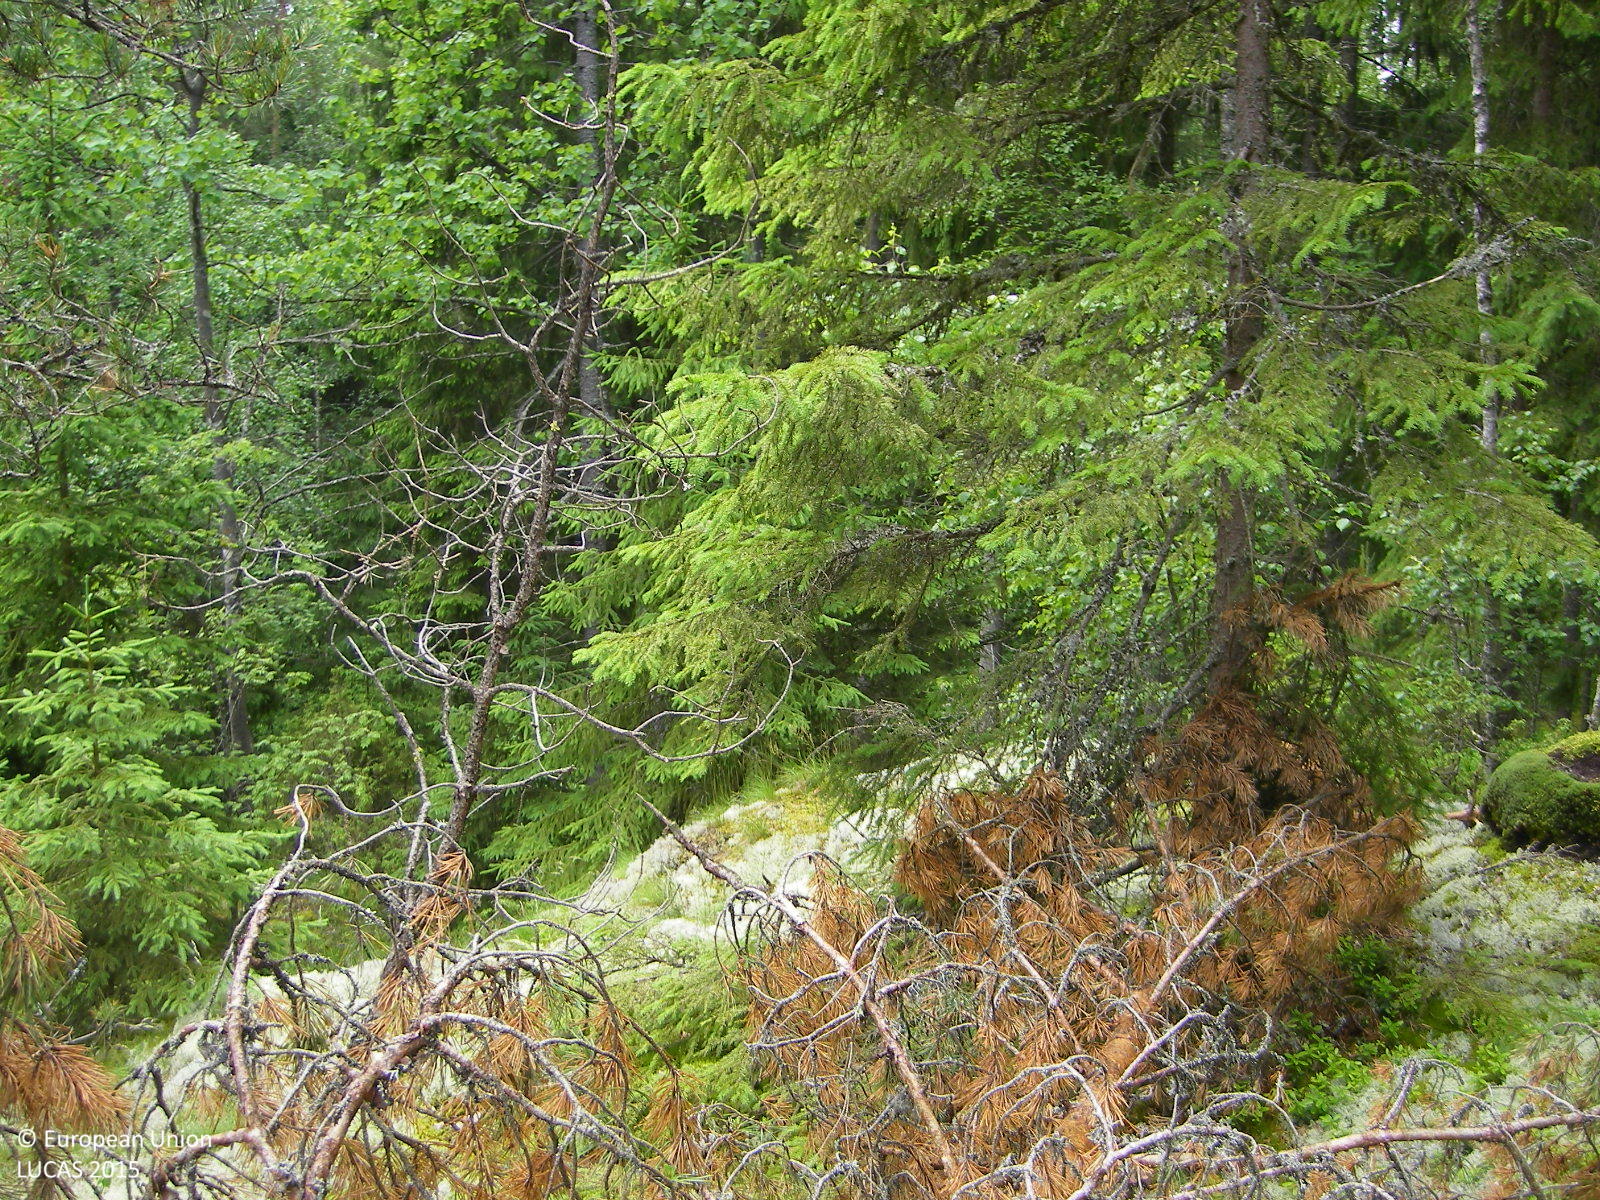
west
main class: Woodland
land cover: Spruce dominated mixed woodland
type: boreal forest
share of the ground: > 75 %
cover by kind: coniferous forest trees 60 %, broadleaved forest trees 25 %, lichens and mosses 10 %, shrubs 5 %
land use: Forestry
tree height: > 5 m
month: June
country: FI
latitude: 60.4020
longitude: 23.3530
